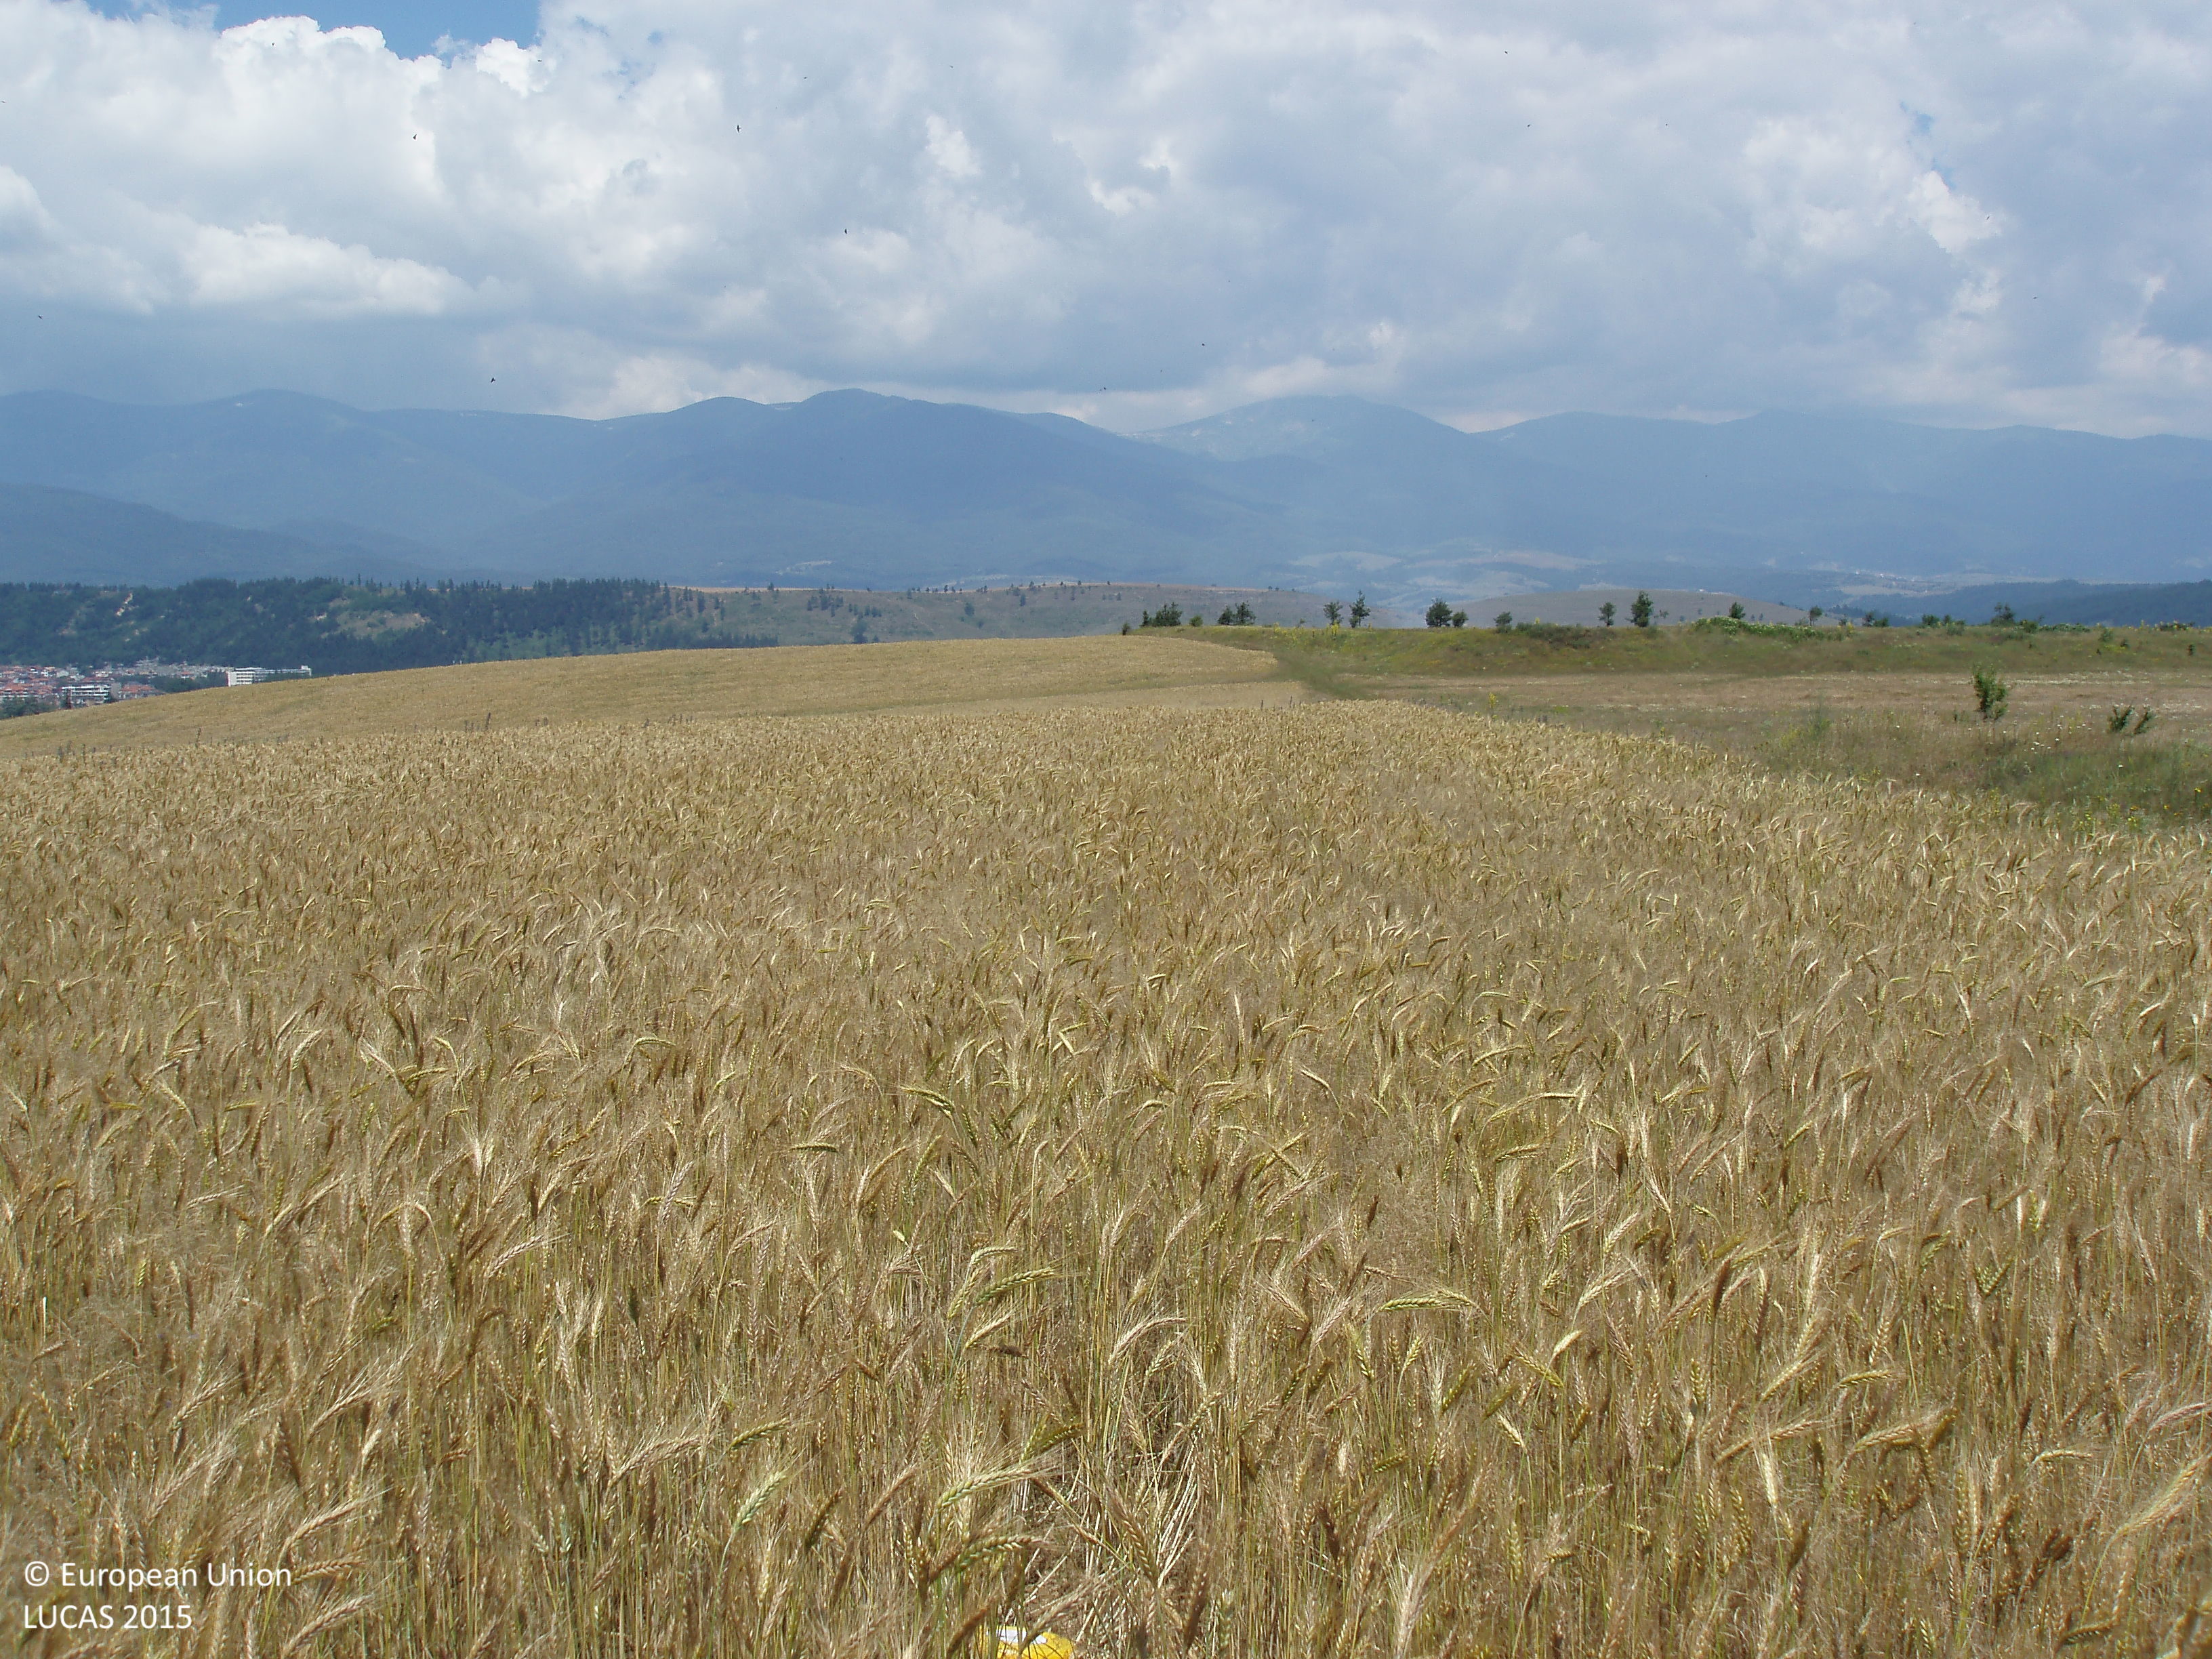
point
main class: Cropland
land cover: Common wheat
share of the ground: > 75 %
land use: Agriculture (excluding fallow land and kitchen gardens)
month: July
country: BG
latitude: 41.8753
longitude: 23.4872
